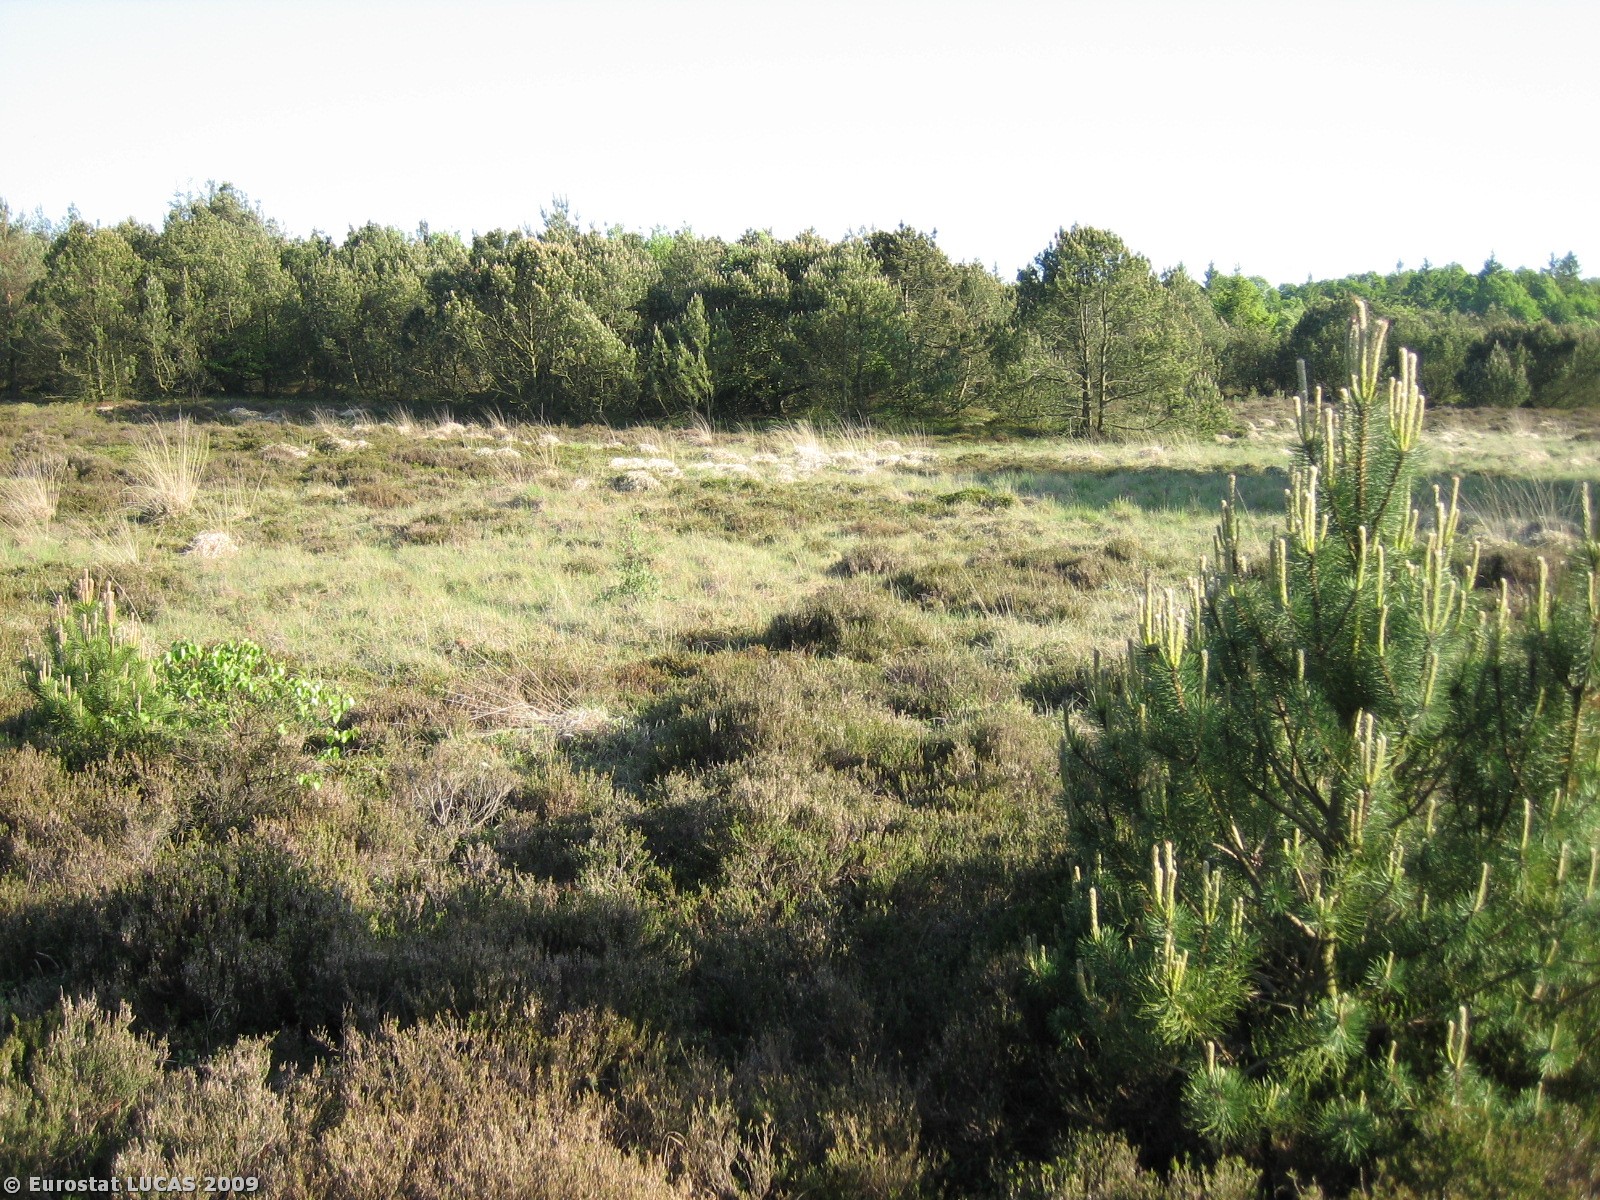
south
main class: Shrubland
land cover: Shrubland with sparse tree cover
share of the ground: > 75 %
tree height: > 5 m
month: May
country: DK
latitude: 55.9696
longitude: 9.2158
